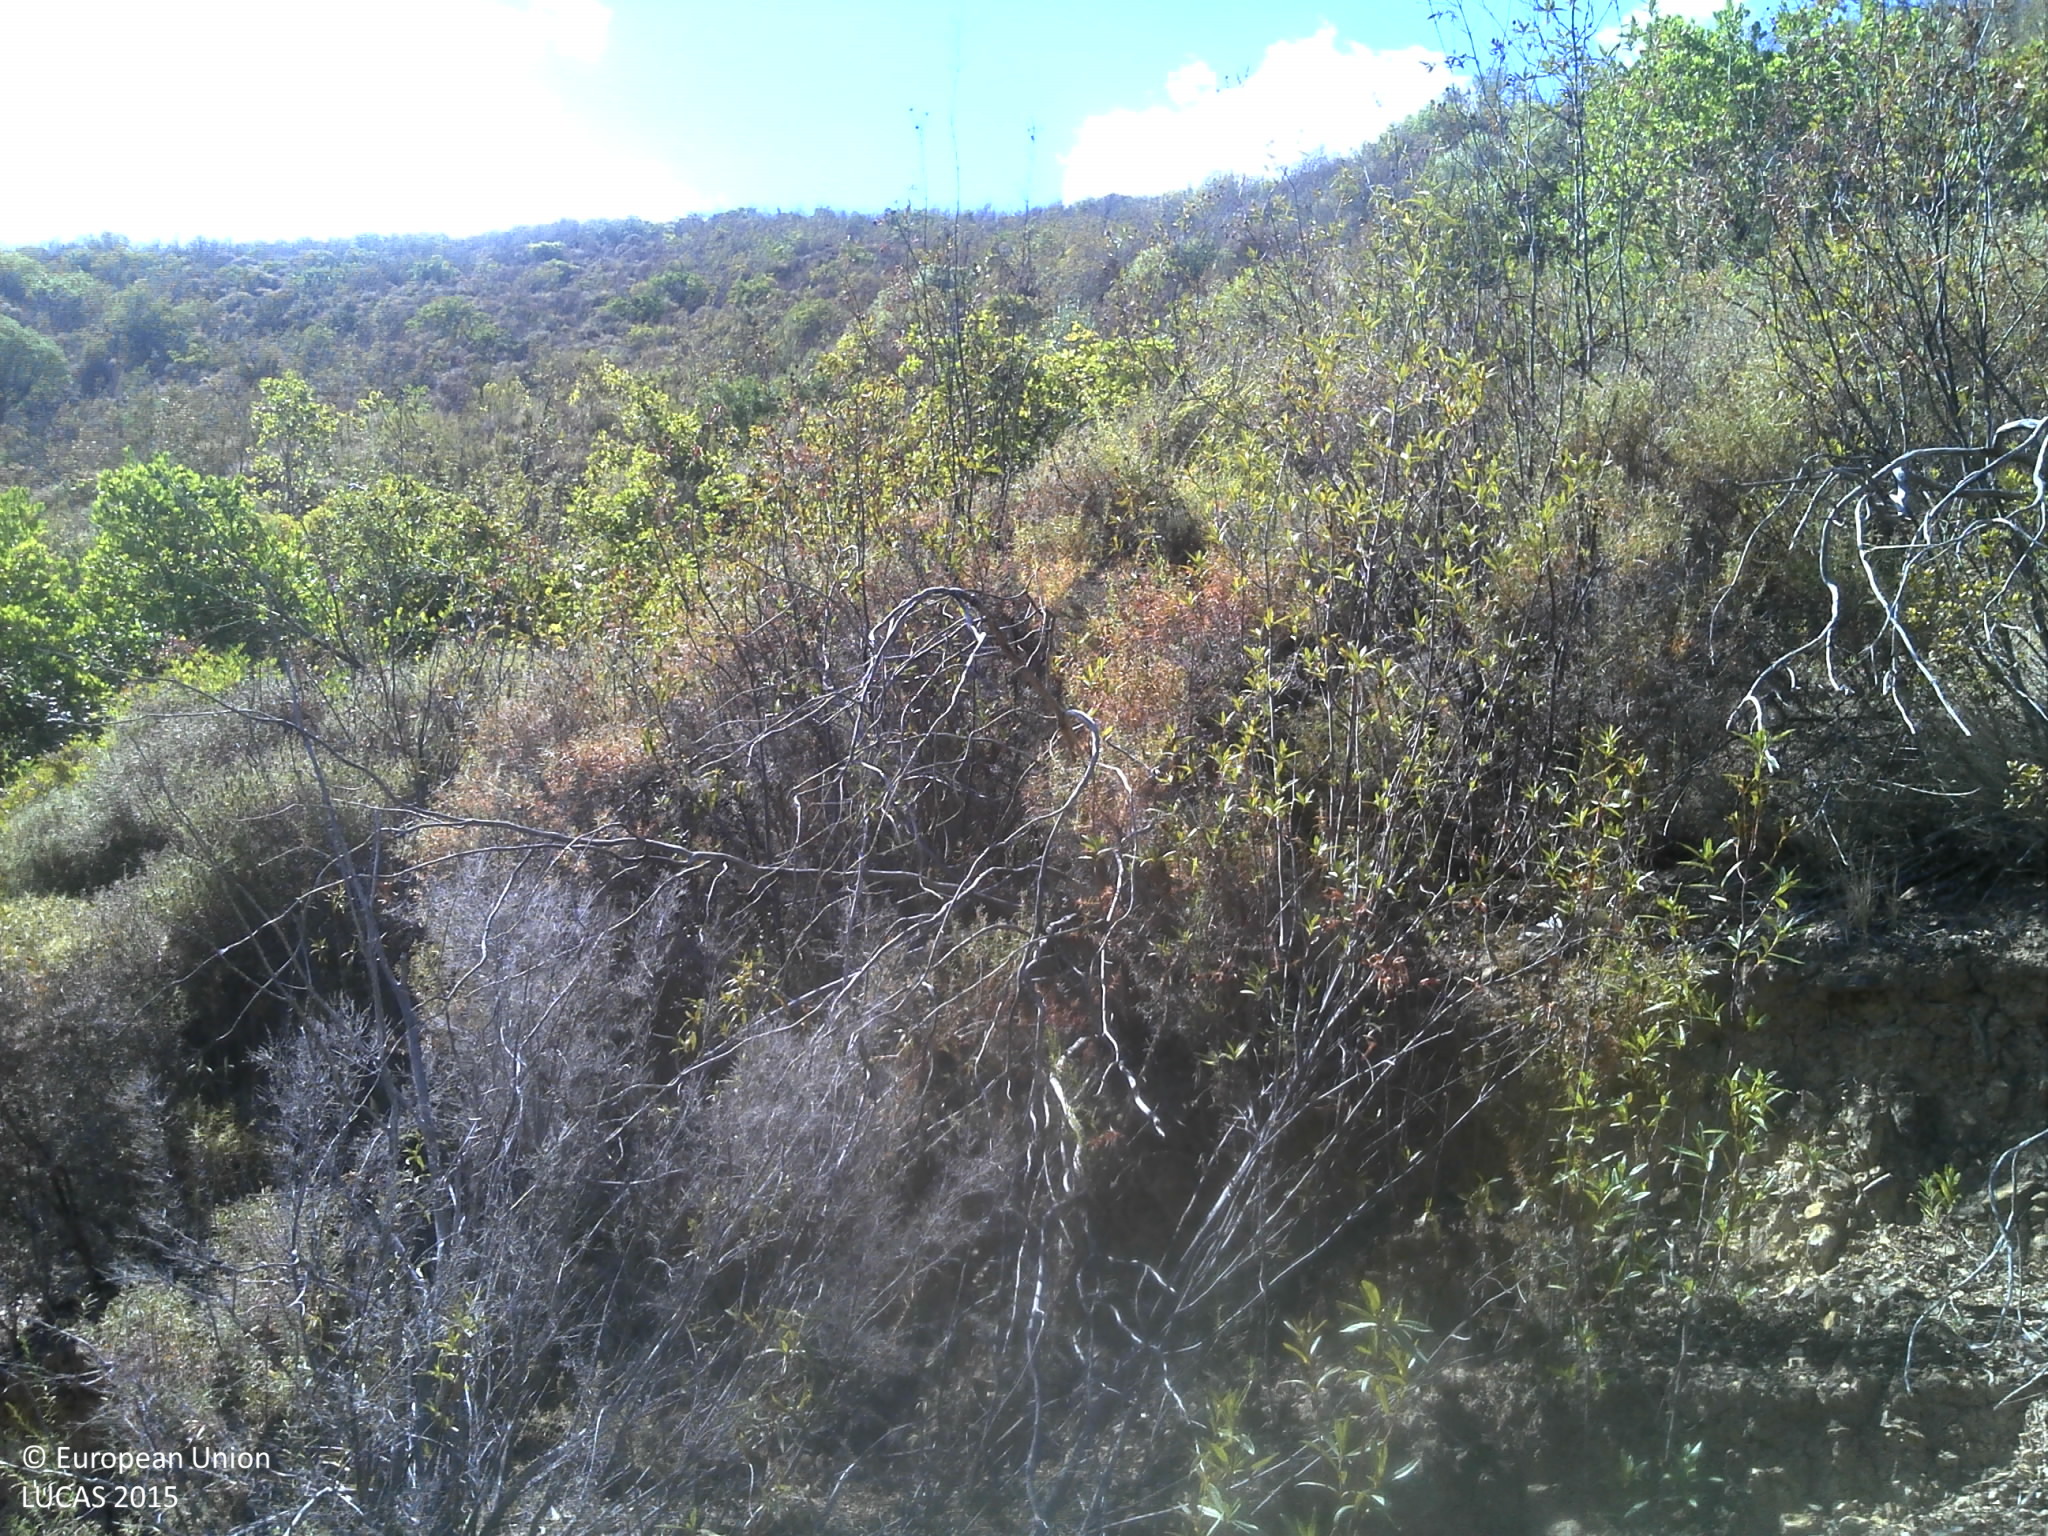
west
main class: Shrubland
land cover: Shrubland without tree cover
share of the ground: 50 - 75 %
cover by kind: shrubs 75 %, unconsolidated bare surface 25 %
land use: Abandoned areas
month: September
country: PT
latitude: 37.3402
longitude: -8.2292
